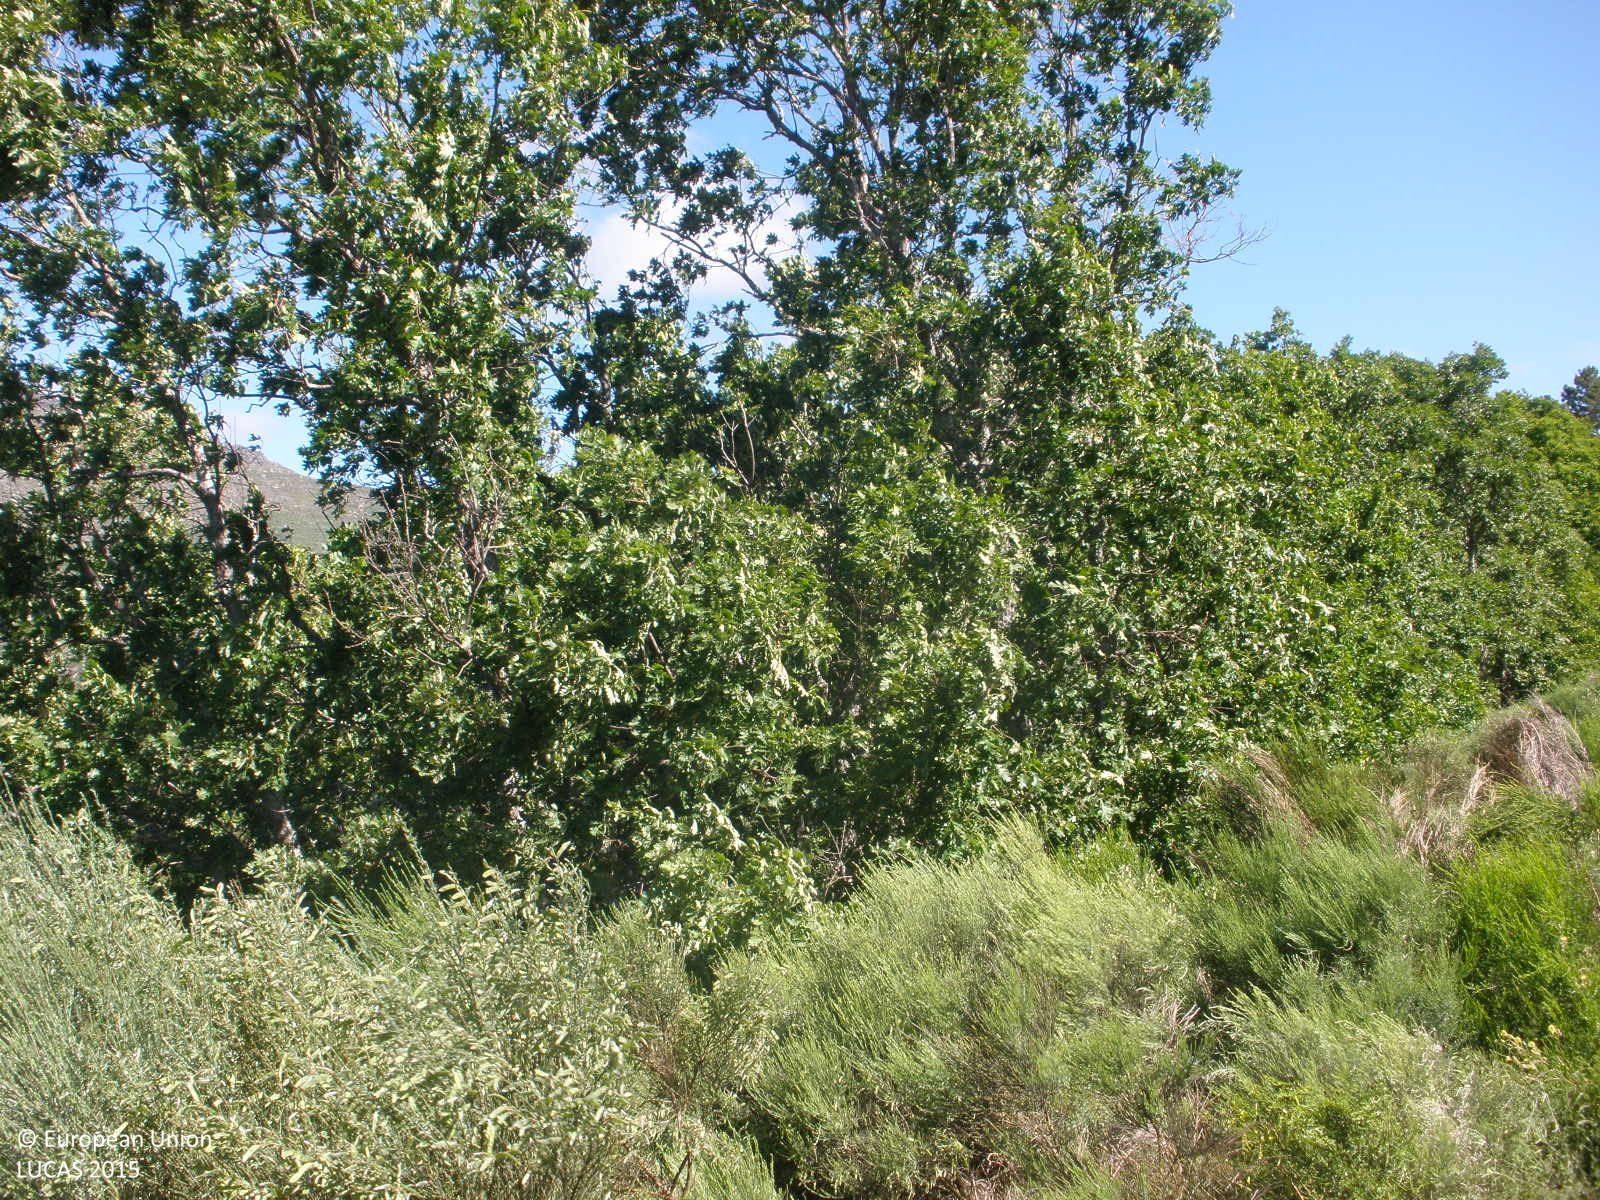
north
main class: Woodland
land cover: Broadleaved woodland
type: broadleaved evergreen forest
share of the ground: > 75 %
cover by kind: broadleaved forest trees 90 %, shrubs 10 %
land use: Forestry
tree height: < 5 m
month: May
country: ES
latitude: 40.2278
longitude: -6.7897
